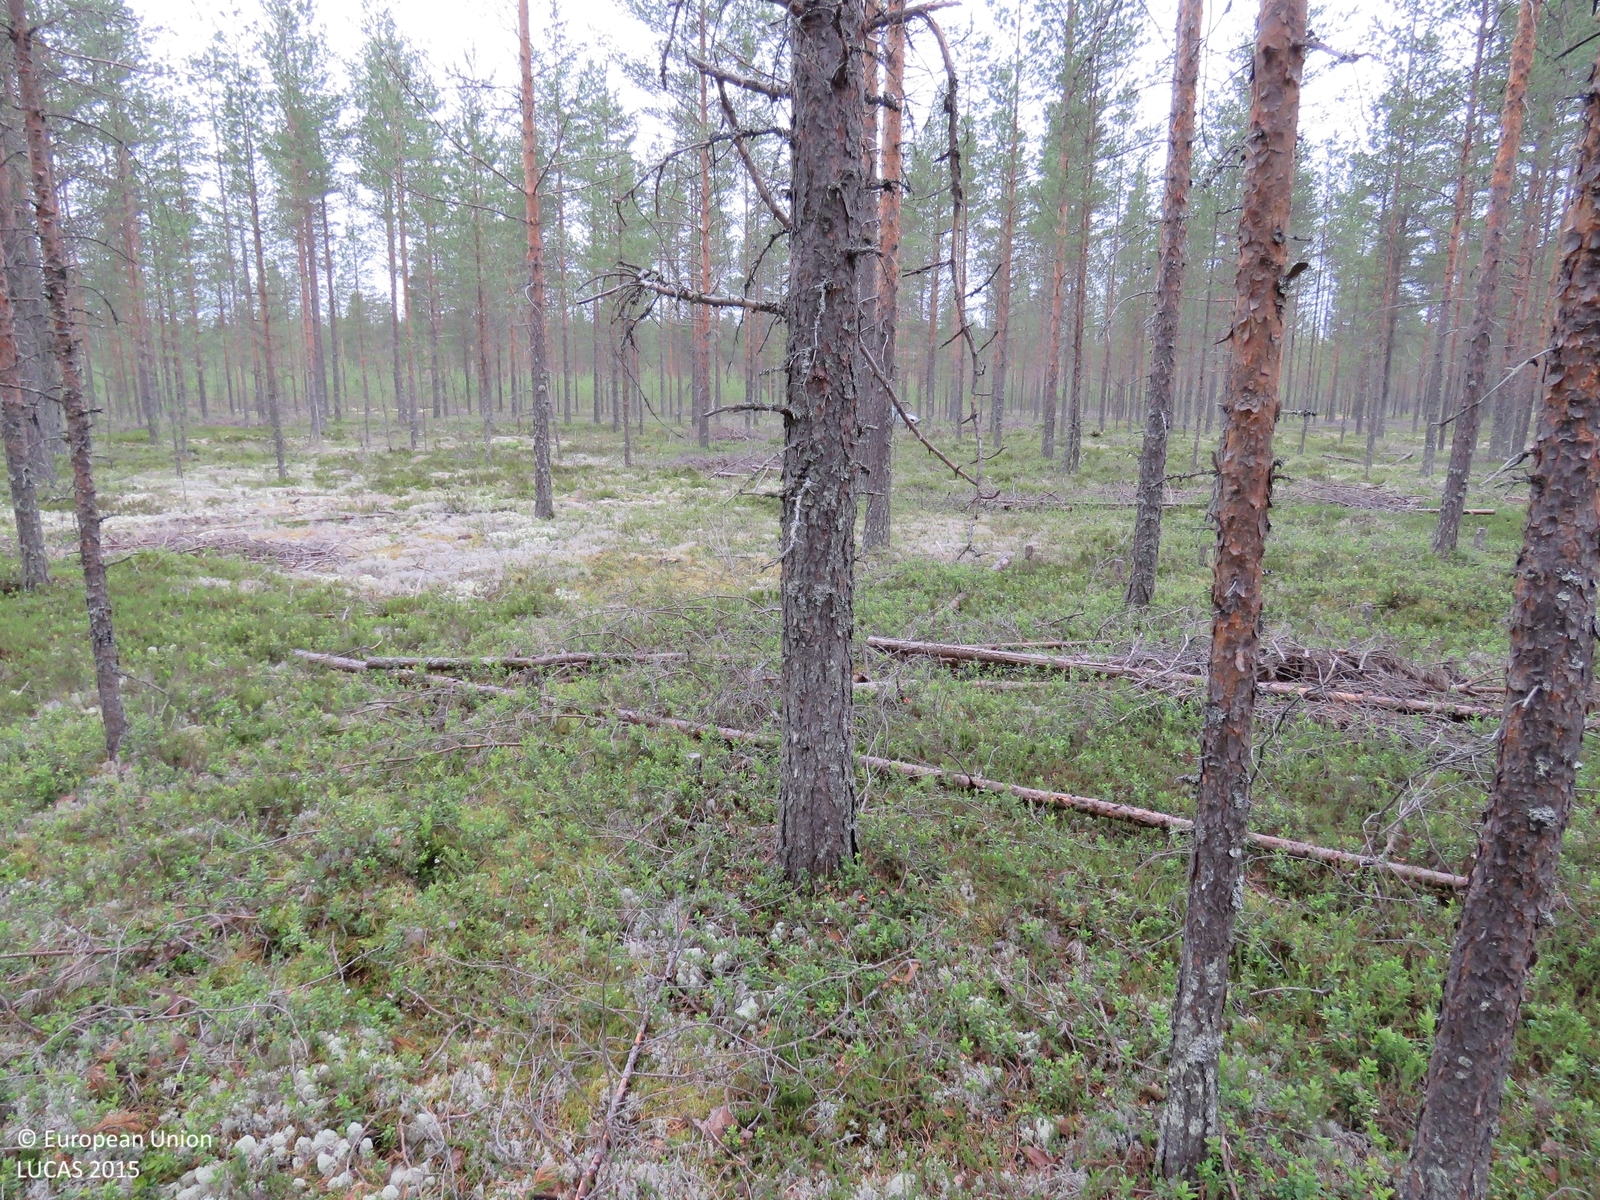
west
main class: Woodland
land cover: Pine dominated coniferous woodland
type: boreal forest
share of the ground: > 75 %
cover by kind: coniferous forest trees 80 %, shrubs 10 %, lichens and mosses 10 %
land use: Forestry
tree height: > 5 m
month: July
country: FI
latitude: 64.3241
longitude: 26.3086
